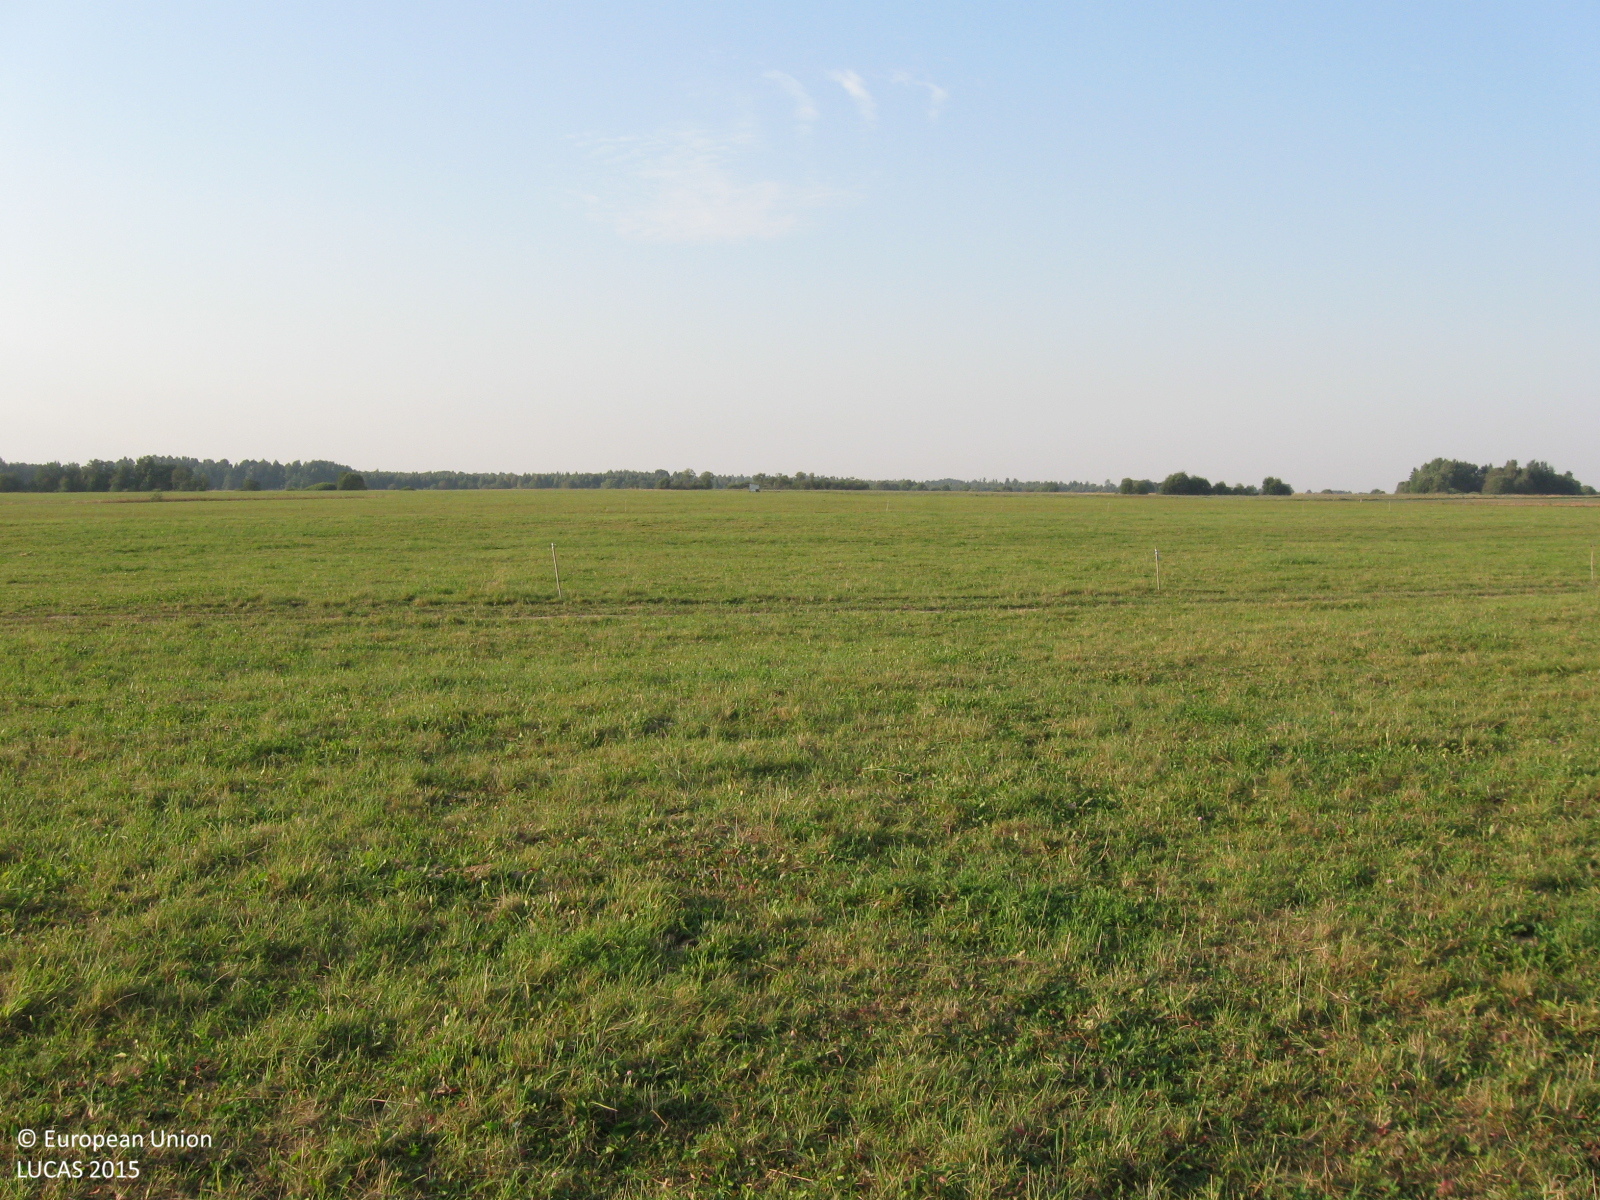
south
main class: Grassland
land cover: Grassland without tree/shrub cover
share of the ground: > 75 %
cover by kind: herbaceous plants 100 %
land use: Agriculture (excluding fallow land and kitchen gardens)
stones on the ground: < 10 %
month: August
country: LT
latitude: 55.5393
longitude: 23.0164
